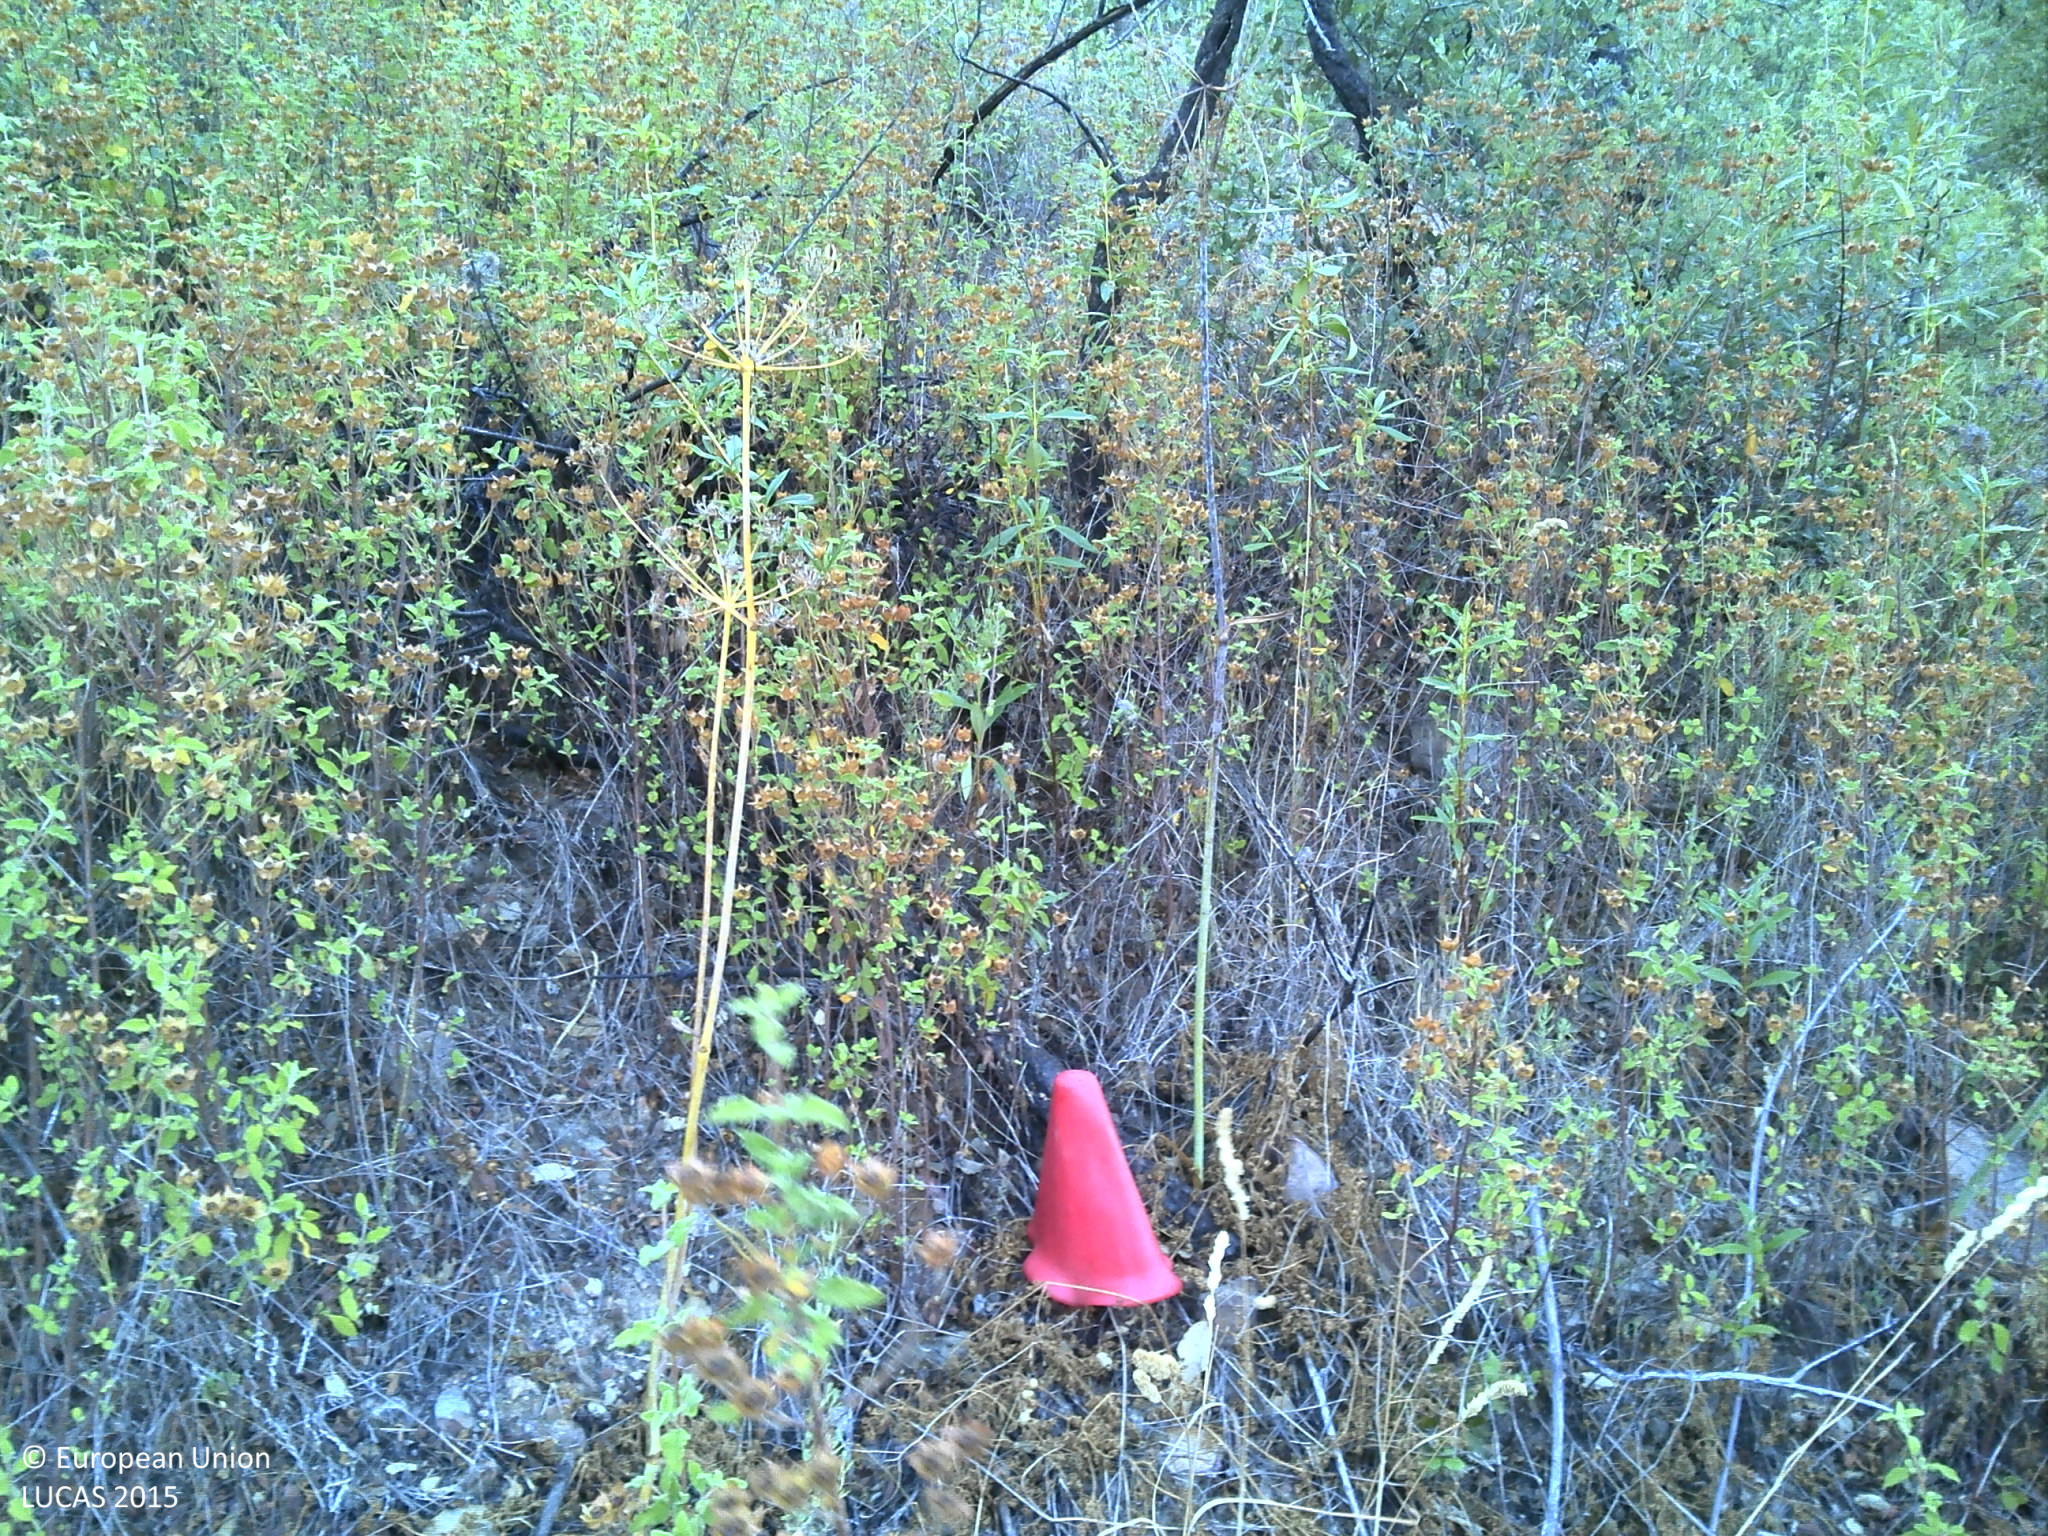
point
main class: Shrubland
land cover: Shrubland with sparse tree cover
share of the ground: > 75 %
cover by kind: shrubs 95 %, broadleaved forest trees 5 %
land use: Abandoned areas
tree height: < 5 m
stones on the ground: < 10 %
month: June
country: PT
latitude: 37.2674
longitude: -7.8402
